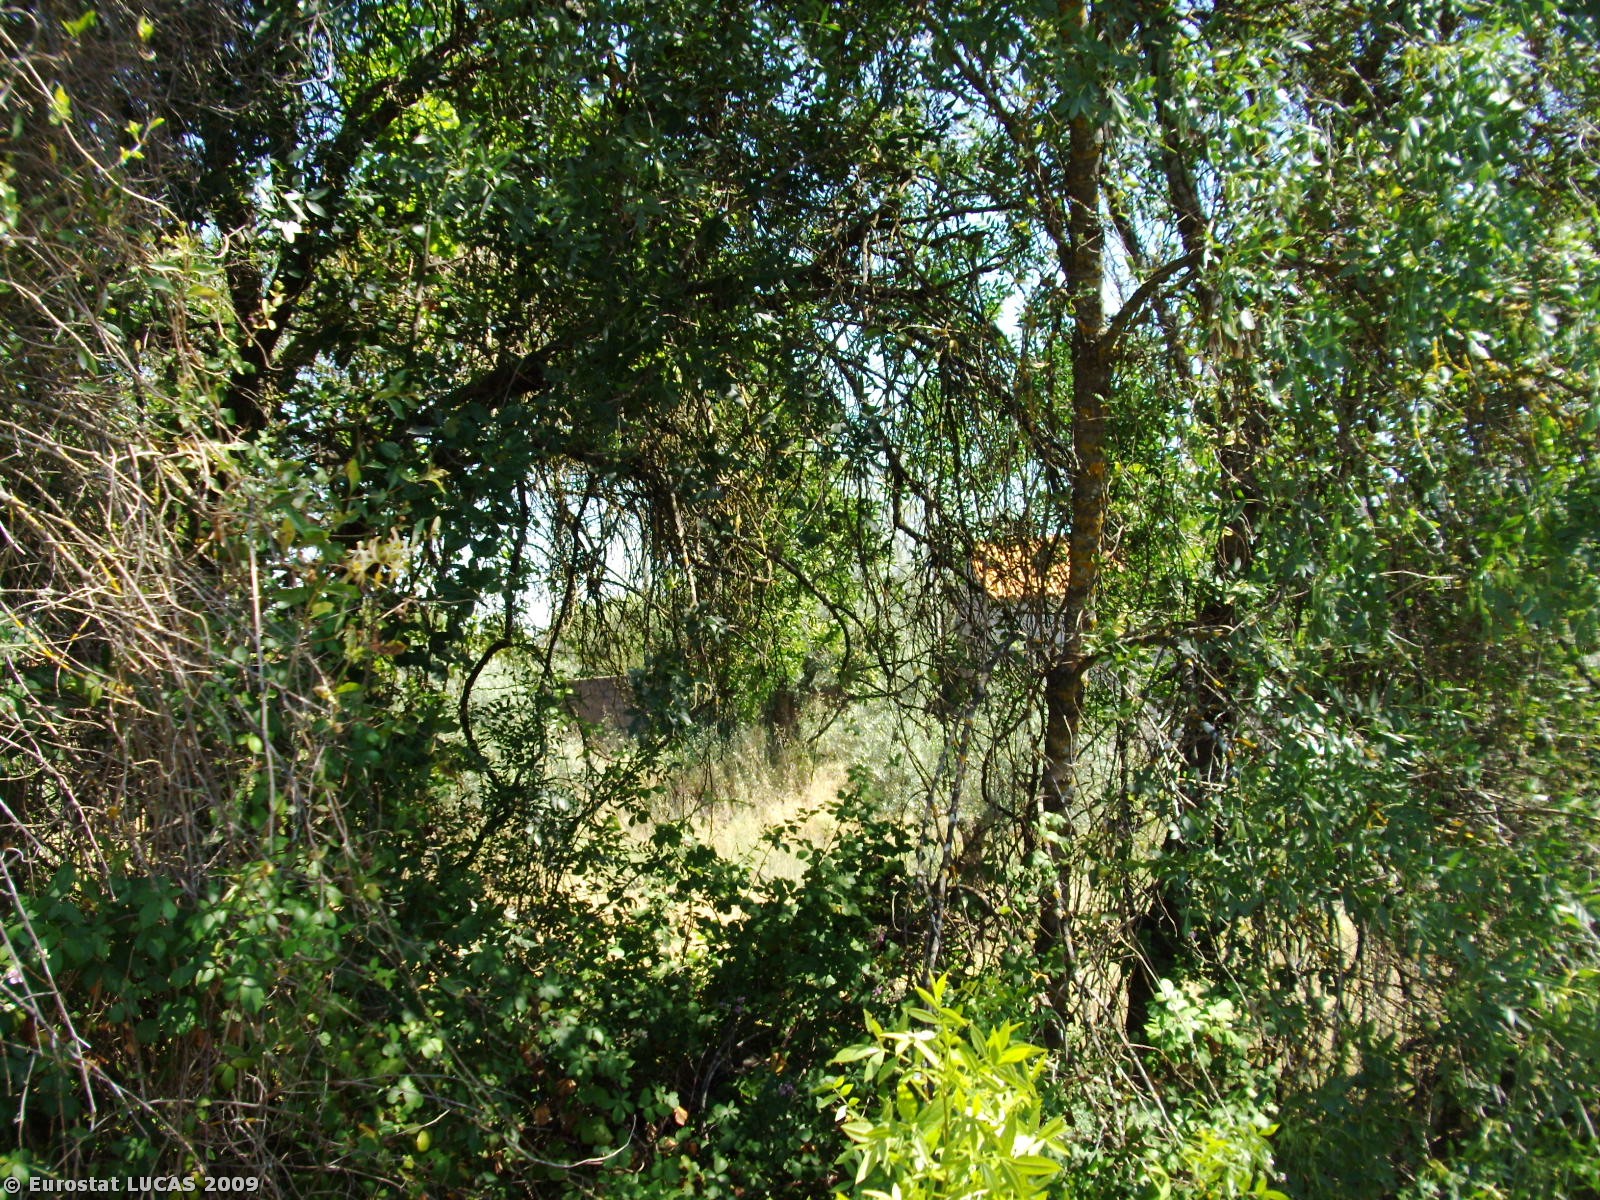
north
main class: Grassland
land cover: Spontaneously vegetated surfaces
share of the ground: > 75 %
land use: Fallow land
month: June
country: PT
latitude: 39.8319
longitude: -7.2583
